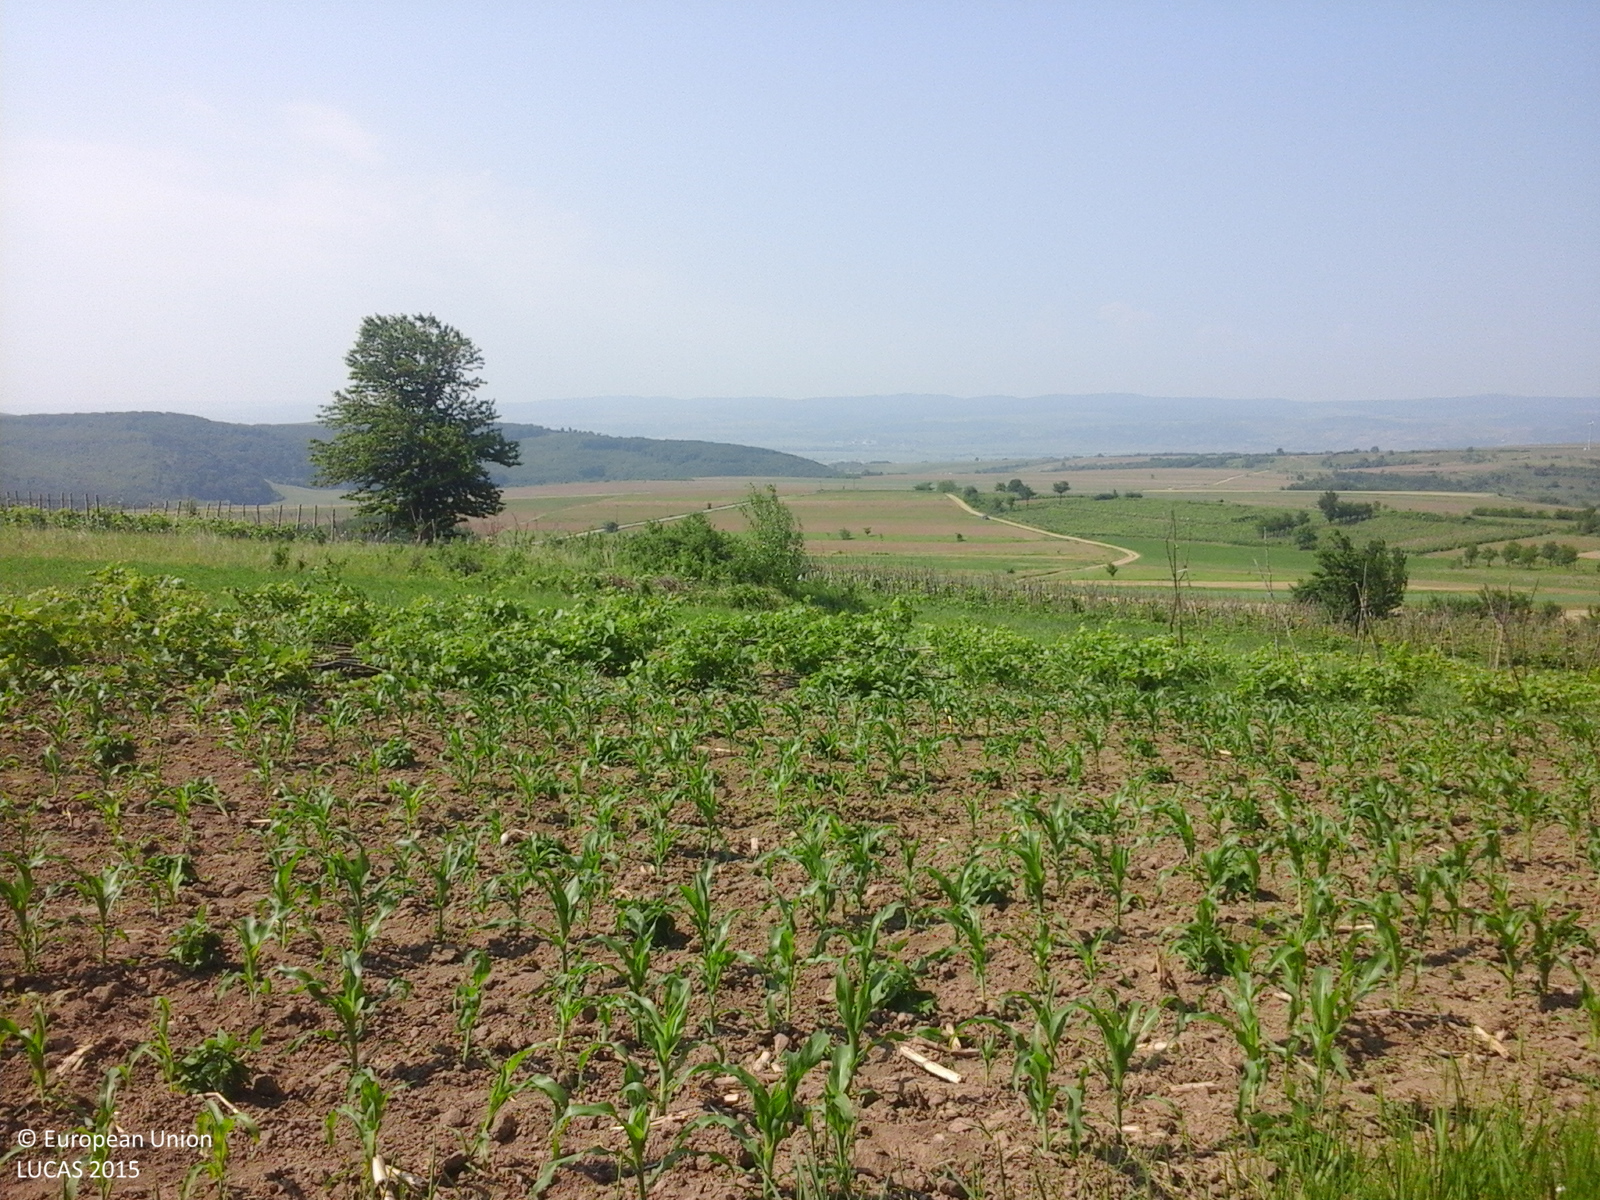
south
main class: Cropland
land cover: Vineyards
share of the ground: 10 - 25 %
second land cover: Grassland without tree/shrub cover
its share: 50 - 75 %
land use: Agriculture (excluding fallow land and kitchen gardens)
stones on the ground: < 10 %
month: June
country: RO
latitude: 46.3399
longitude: 27.1045
